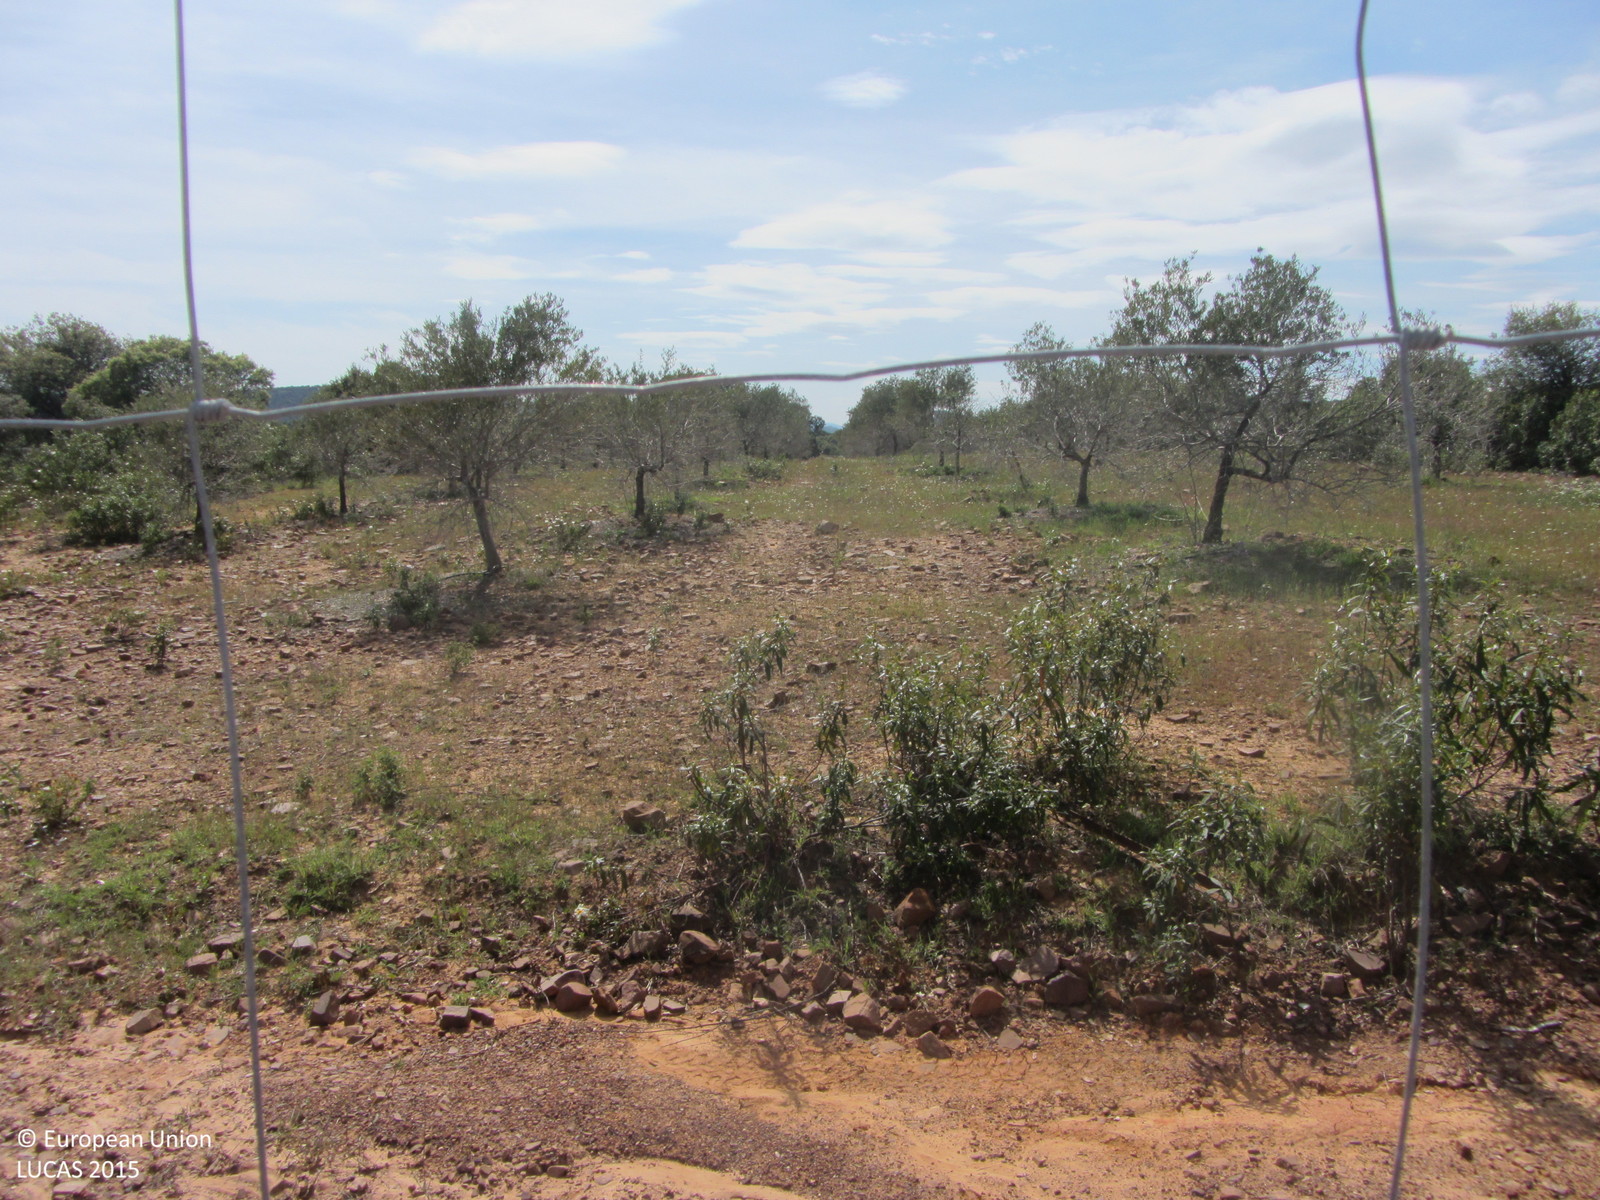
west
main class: Cropland
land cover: Olive groves
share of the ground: 10 - 25 %
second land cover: Spontaneously vegetated surfaces
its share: 50 - 75 %
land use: Agriculture (excluding fallow land and kitchen gardens)
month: May
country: ES
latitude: 38.4328
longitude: -3.0973
